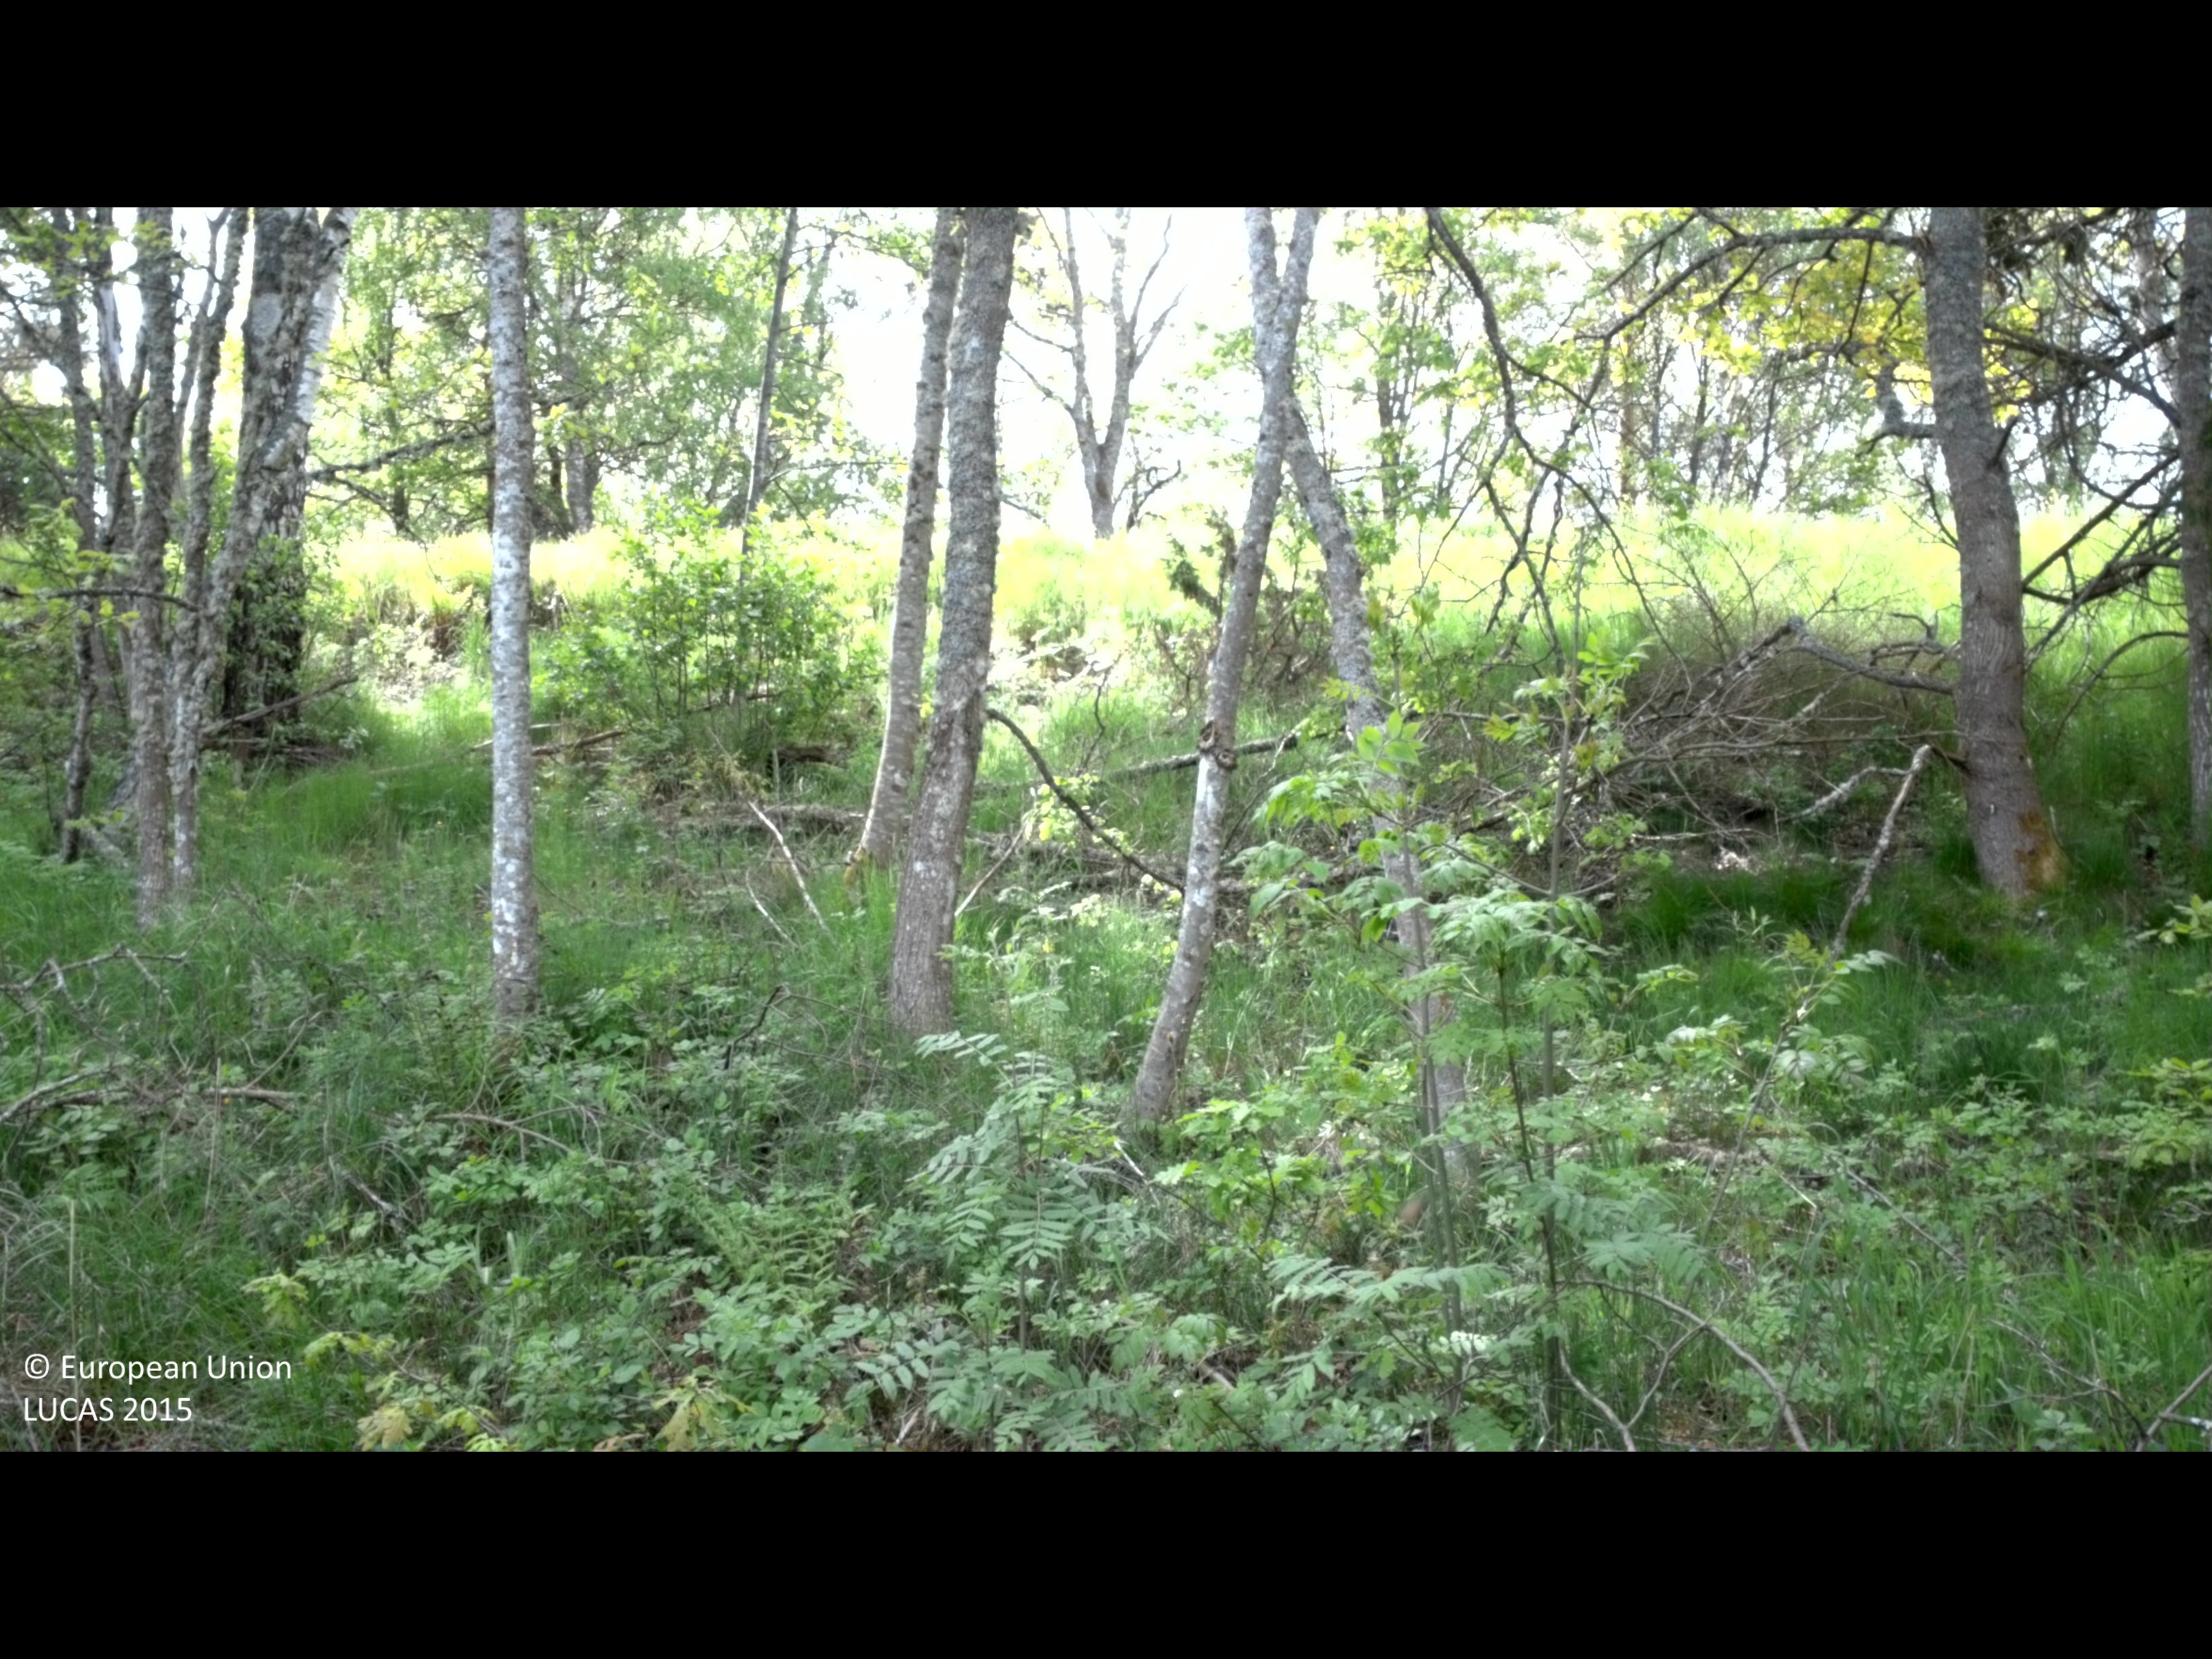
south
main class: Woodland
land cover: Broadleaved woodland
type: mire and swamp forests
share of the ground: > 75 %
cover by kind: broadleaved forest trees 75 %, shrubs 25 %
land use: Amenities, museums, leisure
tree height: > 5 m
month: May
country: SE
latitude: 57.4575
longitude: 16.3159
